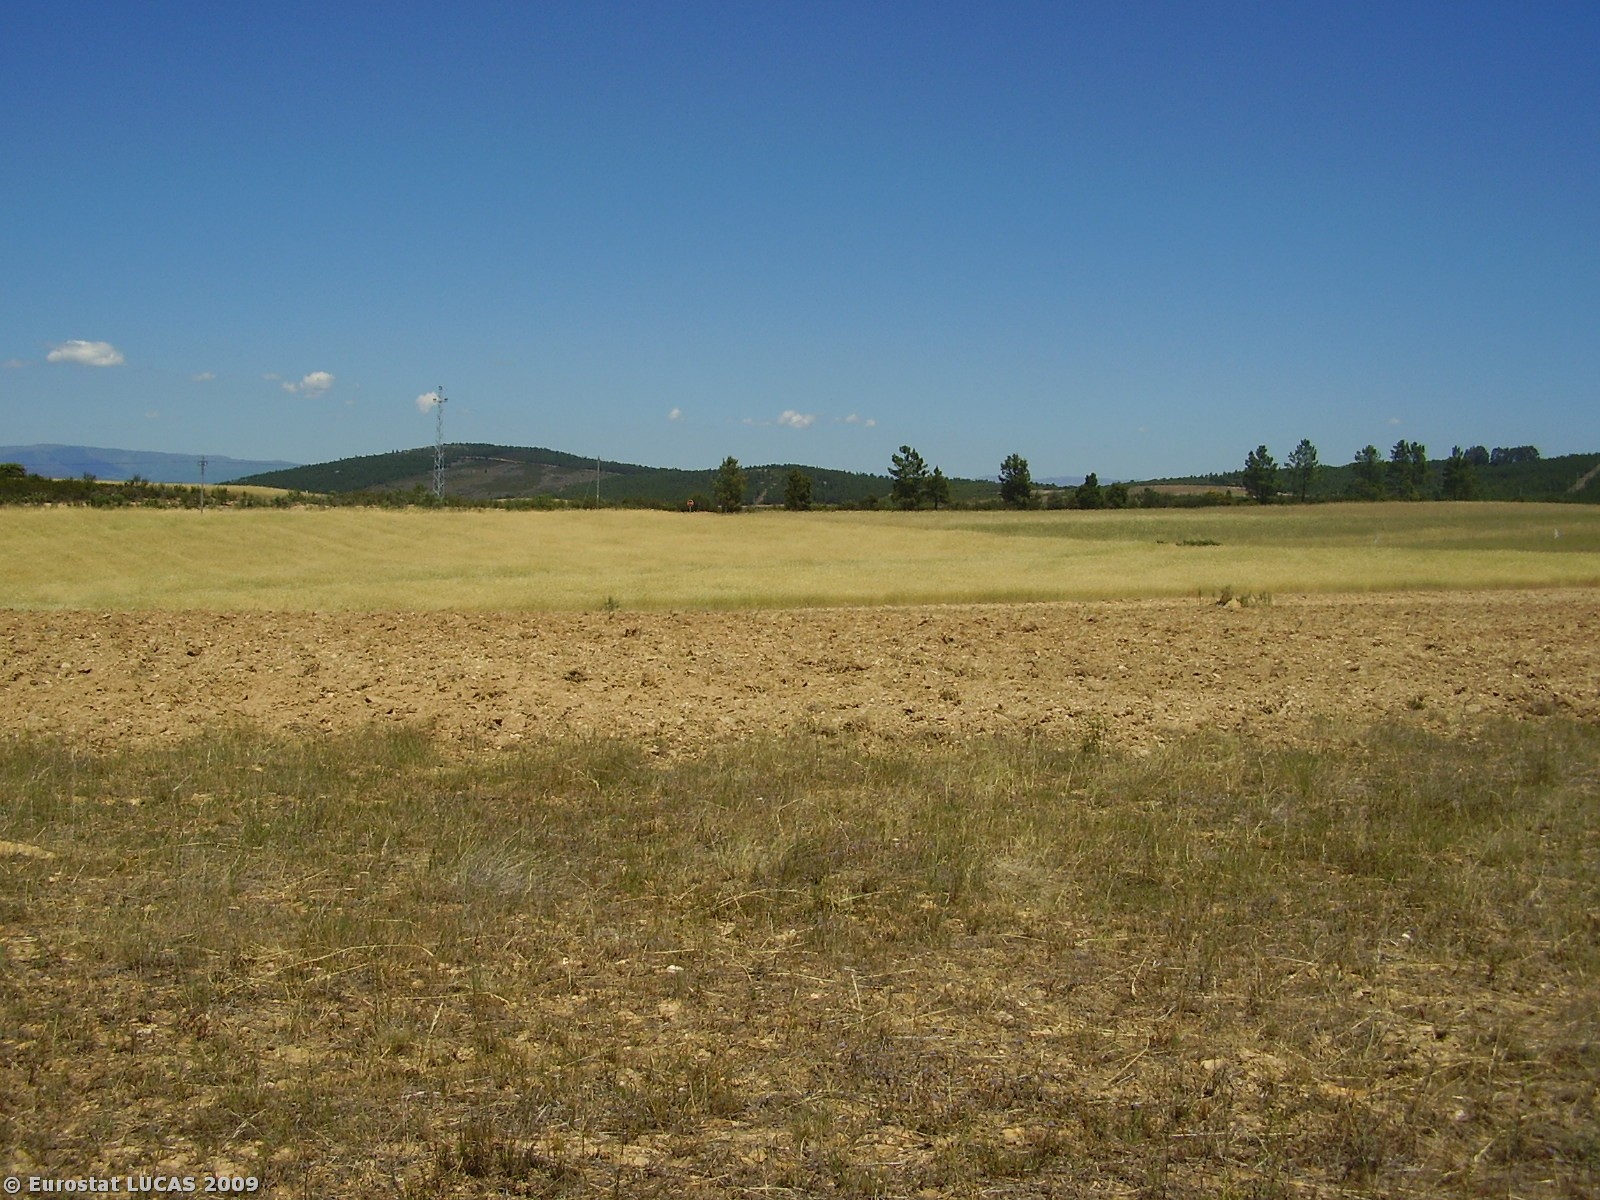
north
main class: Grassland
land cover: Spontaneously vegetated surfaces
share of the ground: 50 - 75 %
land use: Fallow land
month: June
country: PT
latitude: 41.8654
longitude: -6.5786
